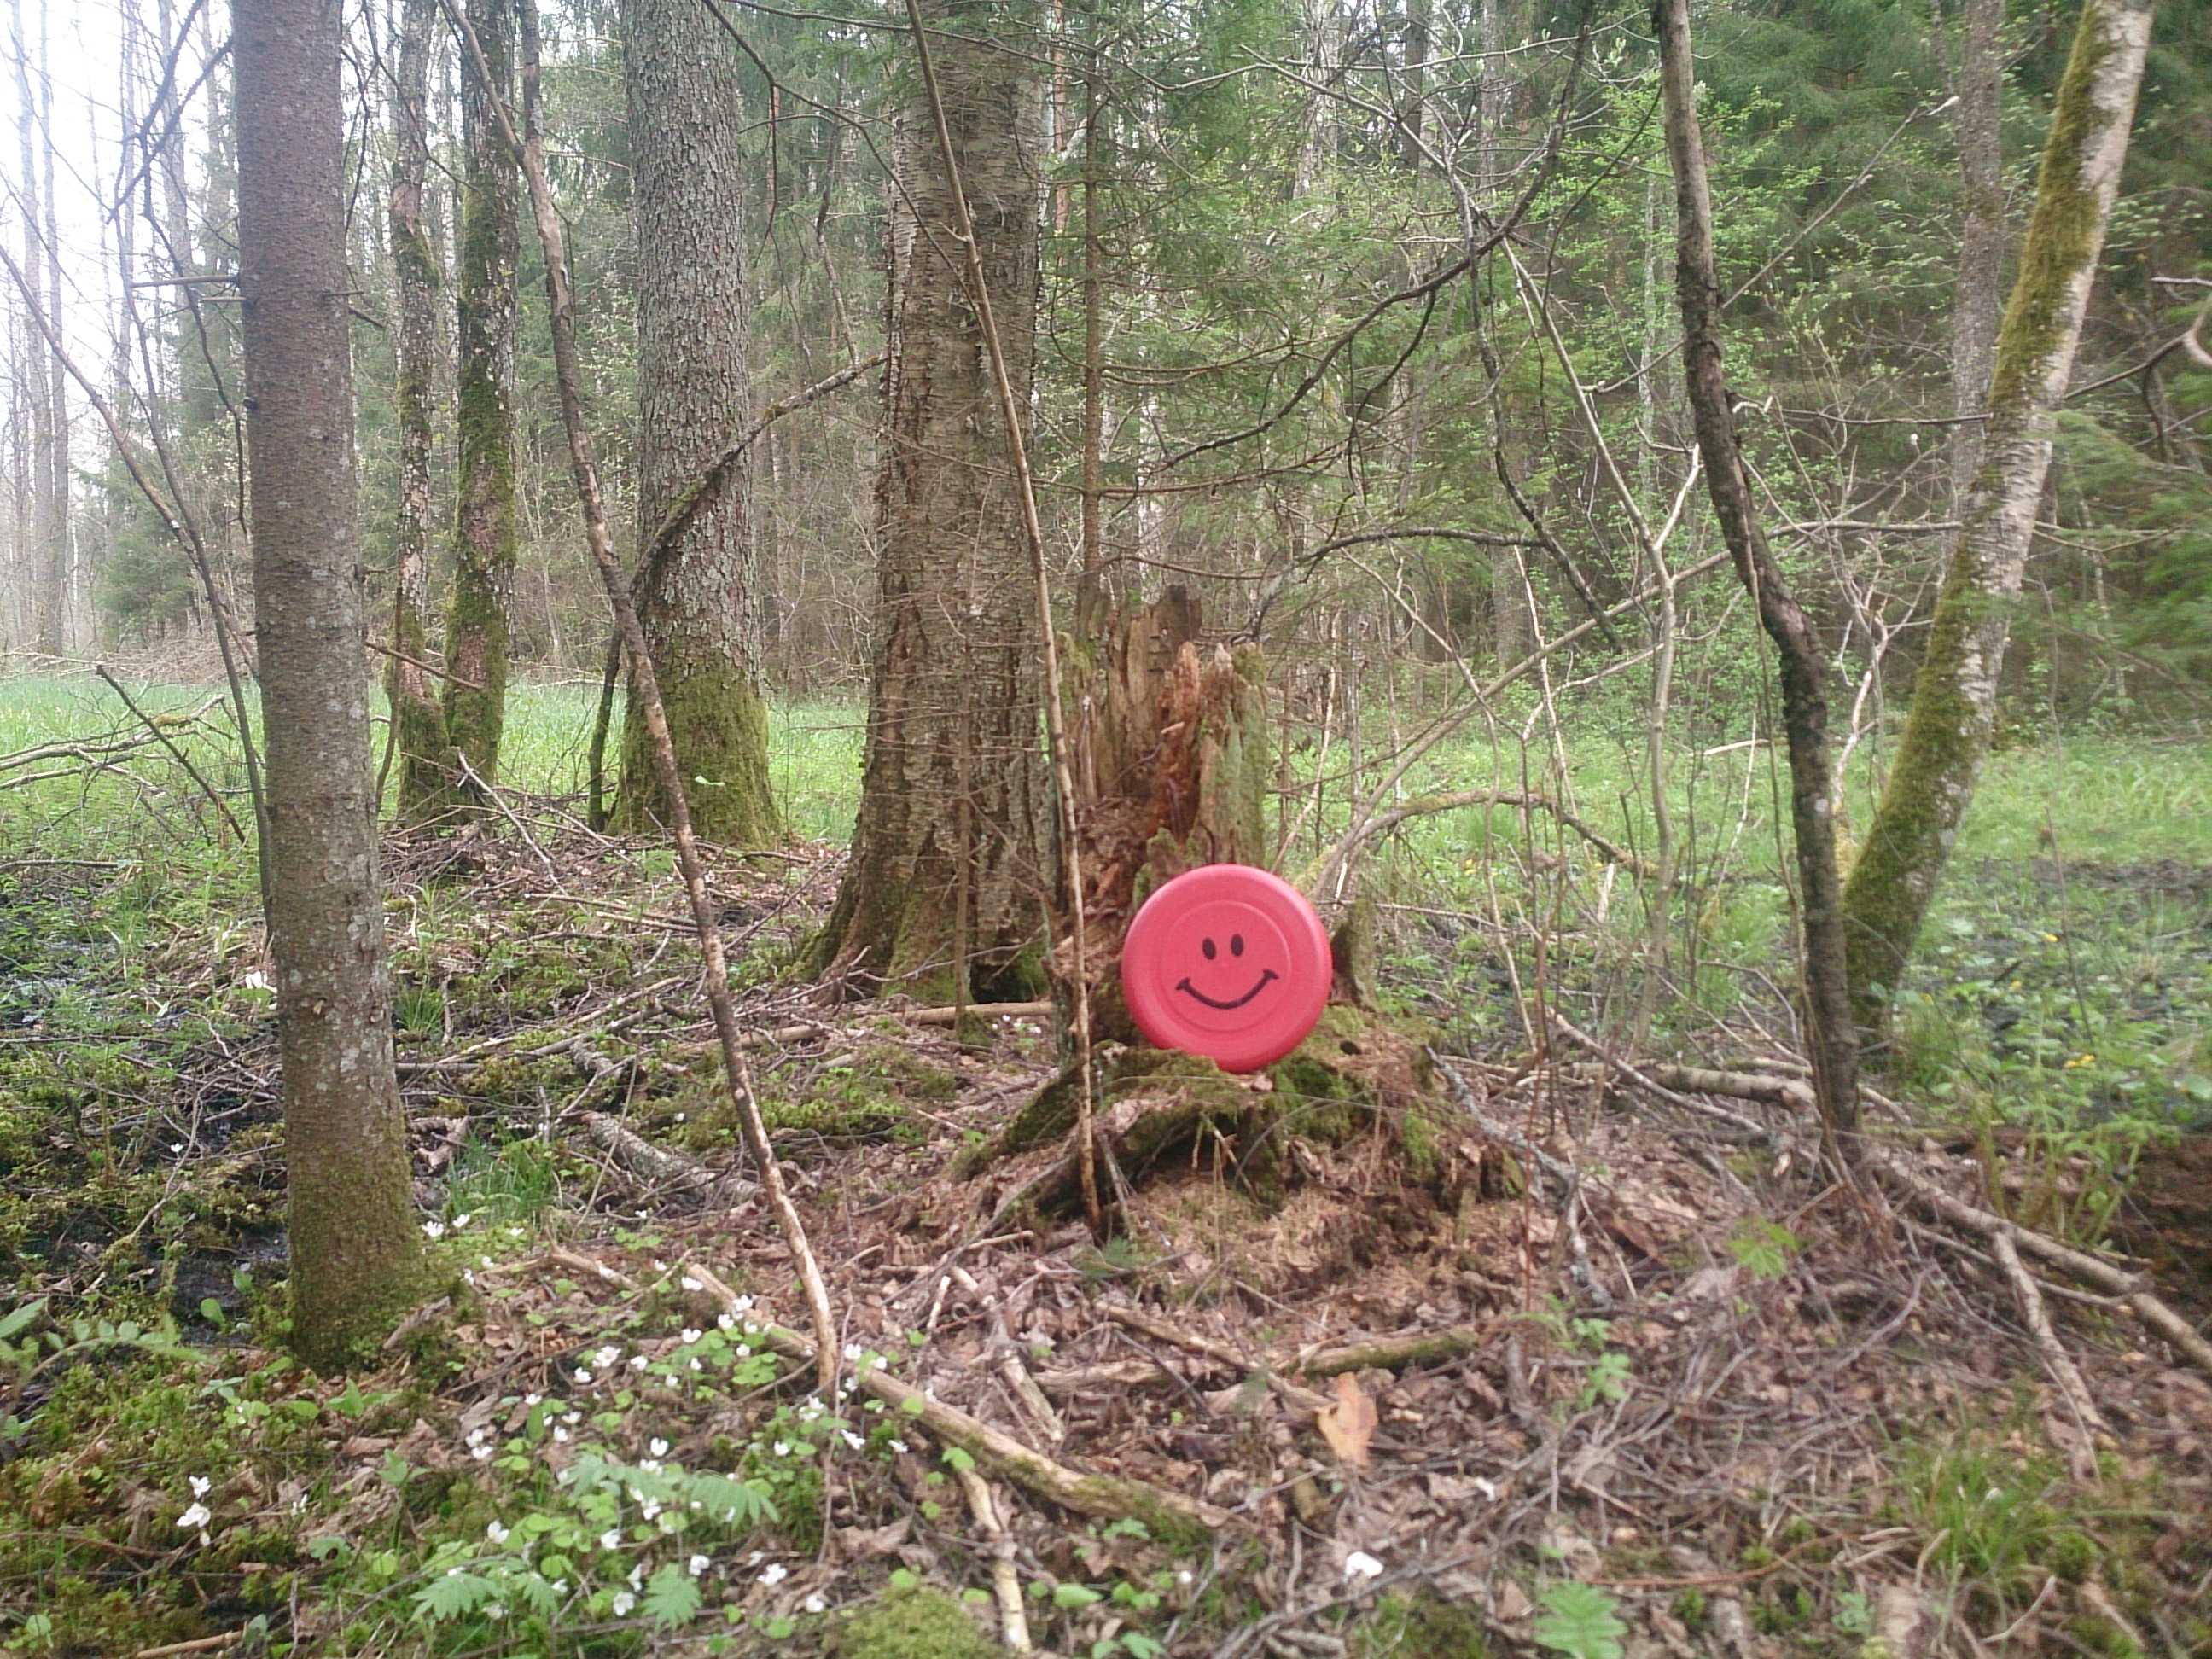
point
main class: Woodland
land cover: Spruce dominated mixed woodland
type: hemiboreal forest and nemoral coniferous forest and mixed broadleaved-coniferous forest
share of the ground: > 75 %
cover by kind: coniferous forest trees 50 %, broadleaved forest trees 50 %
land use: Forestry
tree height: > 5 m
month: May
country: LV
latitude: 56.7040
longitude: 24.2504
